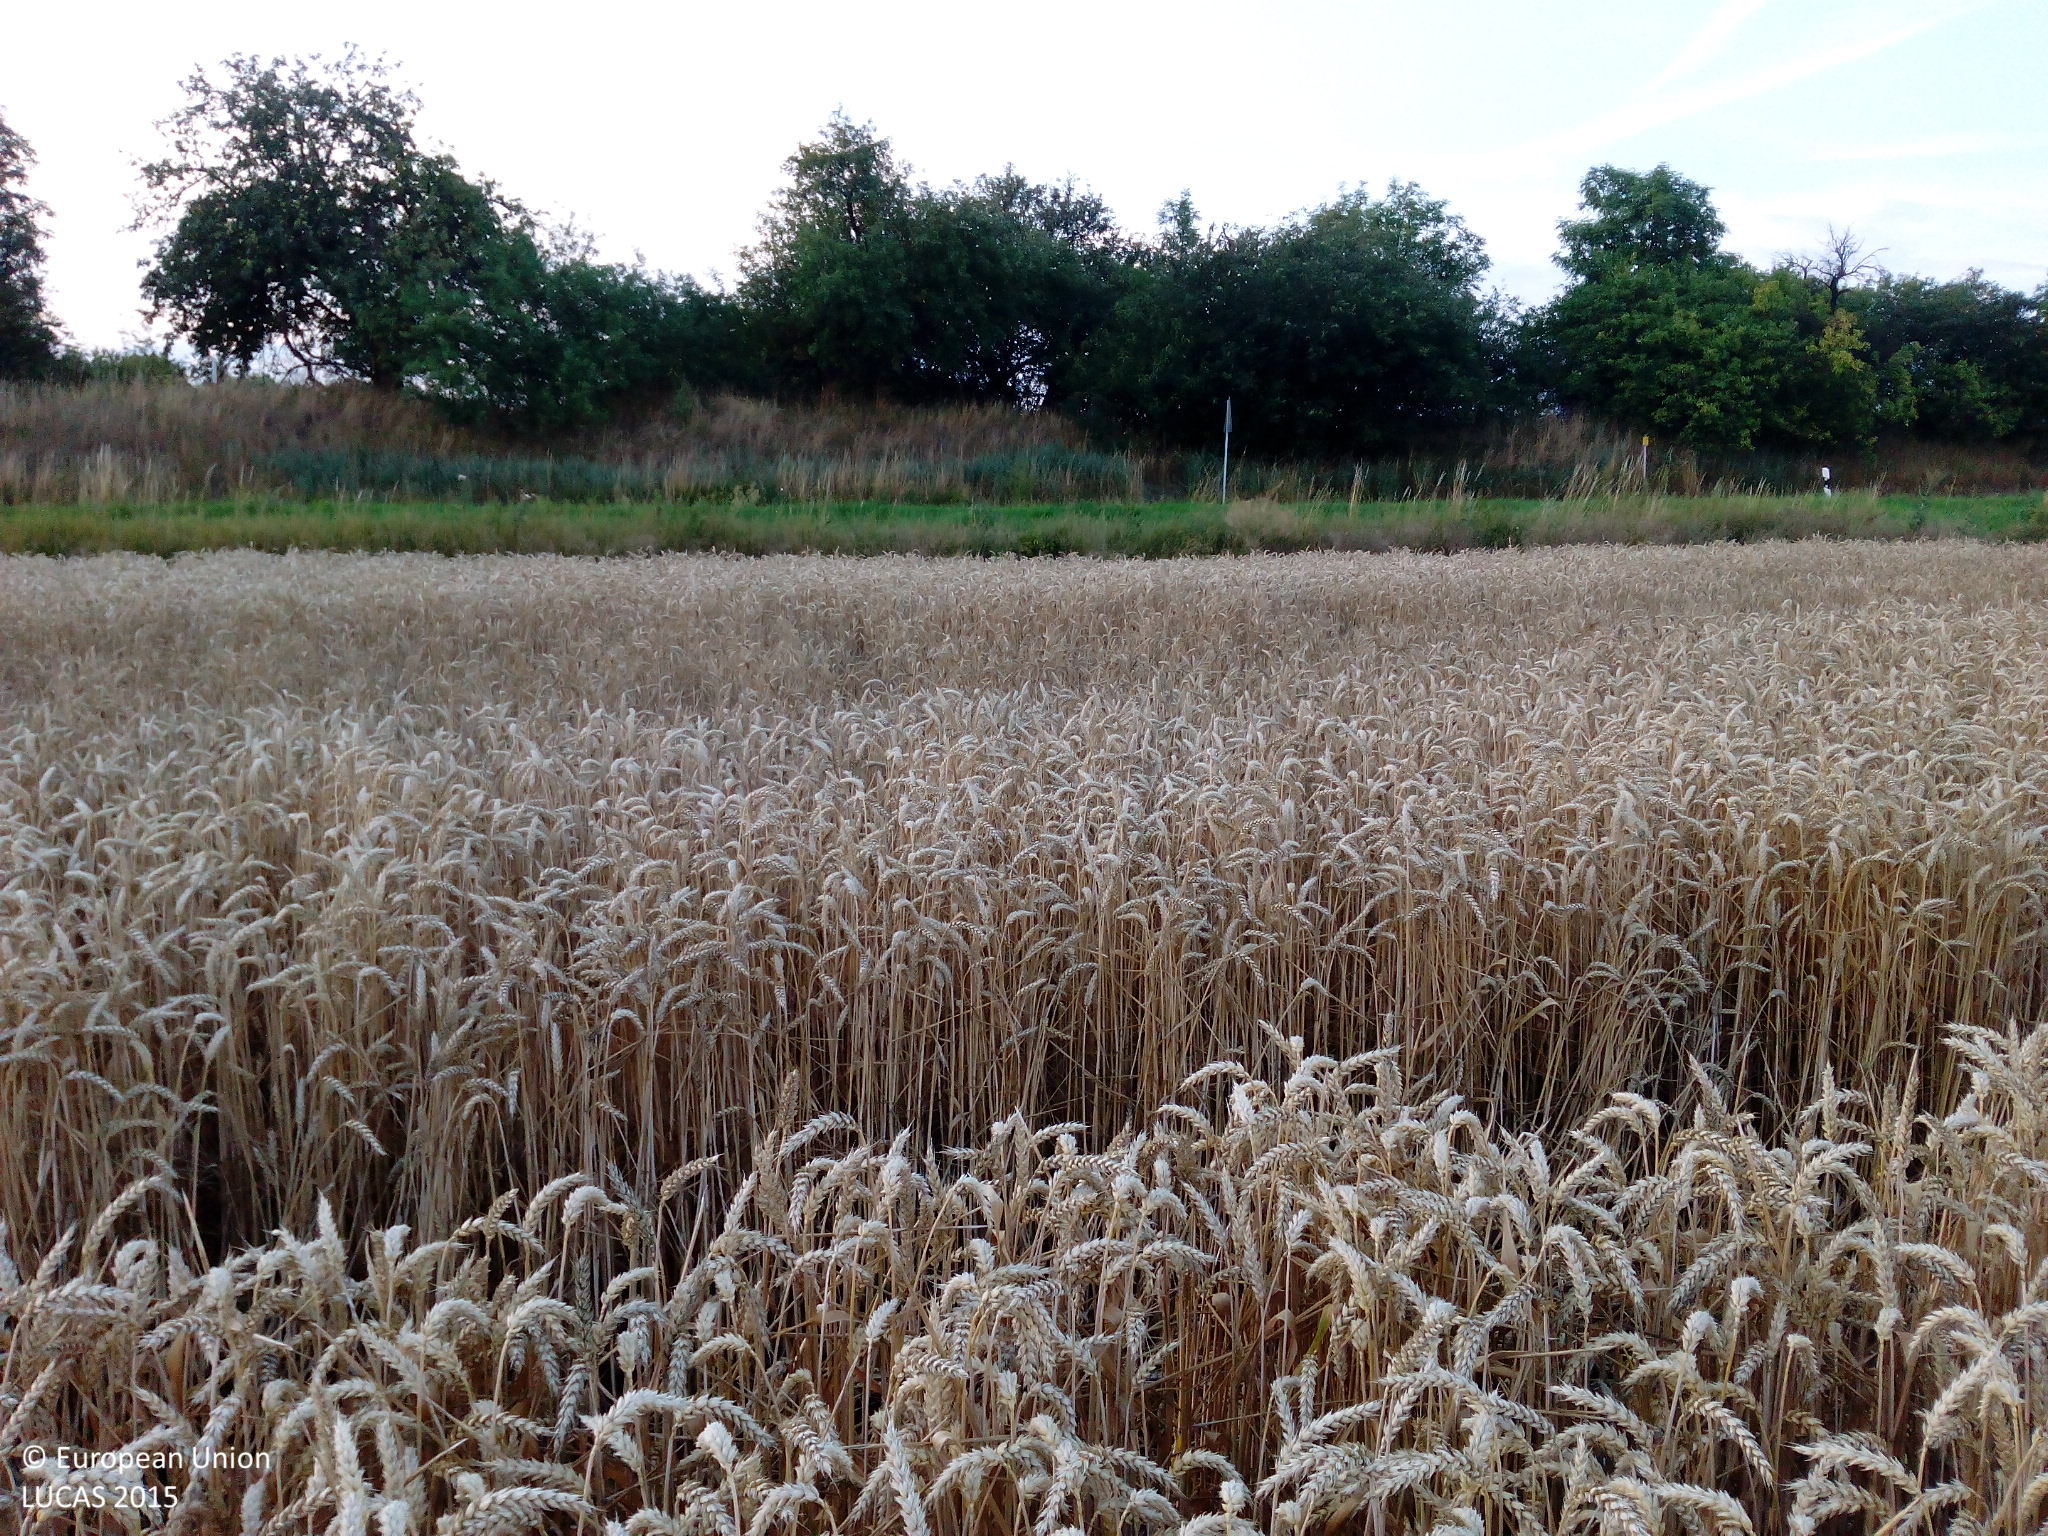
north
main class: Cropland
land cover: Common wheat
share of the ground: > 75 %
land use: Agriculture (excluding fallow land and kitchen gardens)
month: July
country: DE
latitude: 52.7186
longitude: 14.1610
